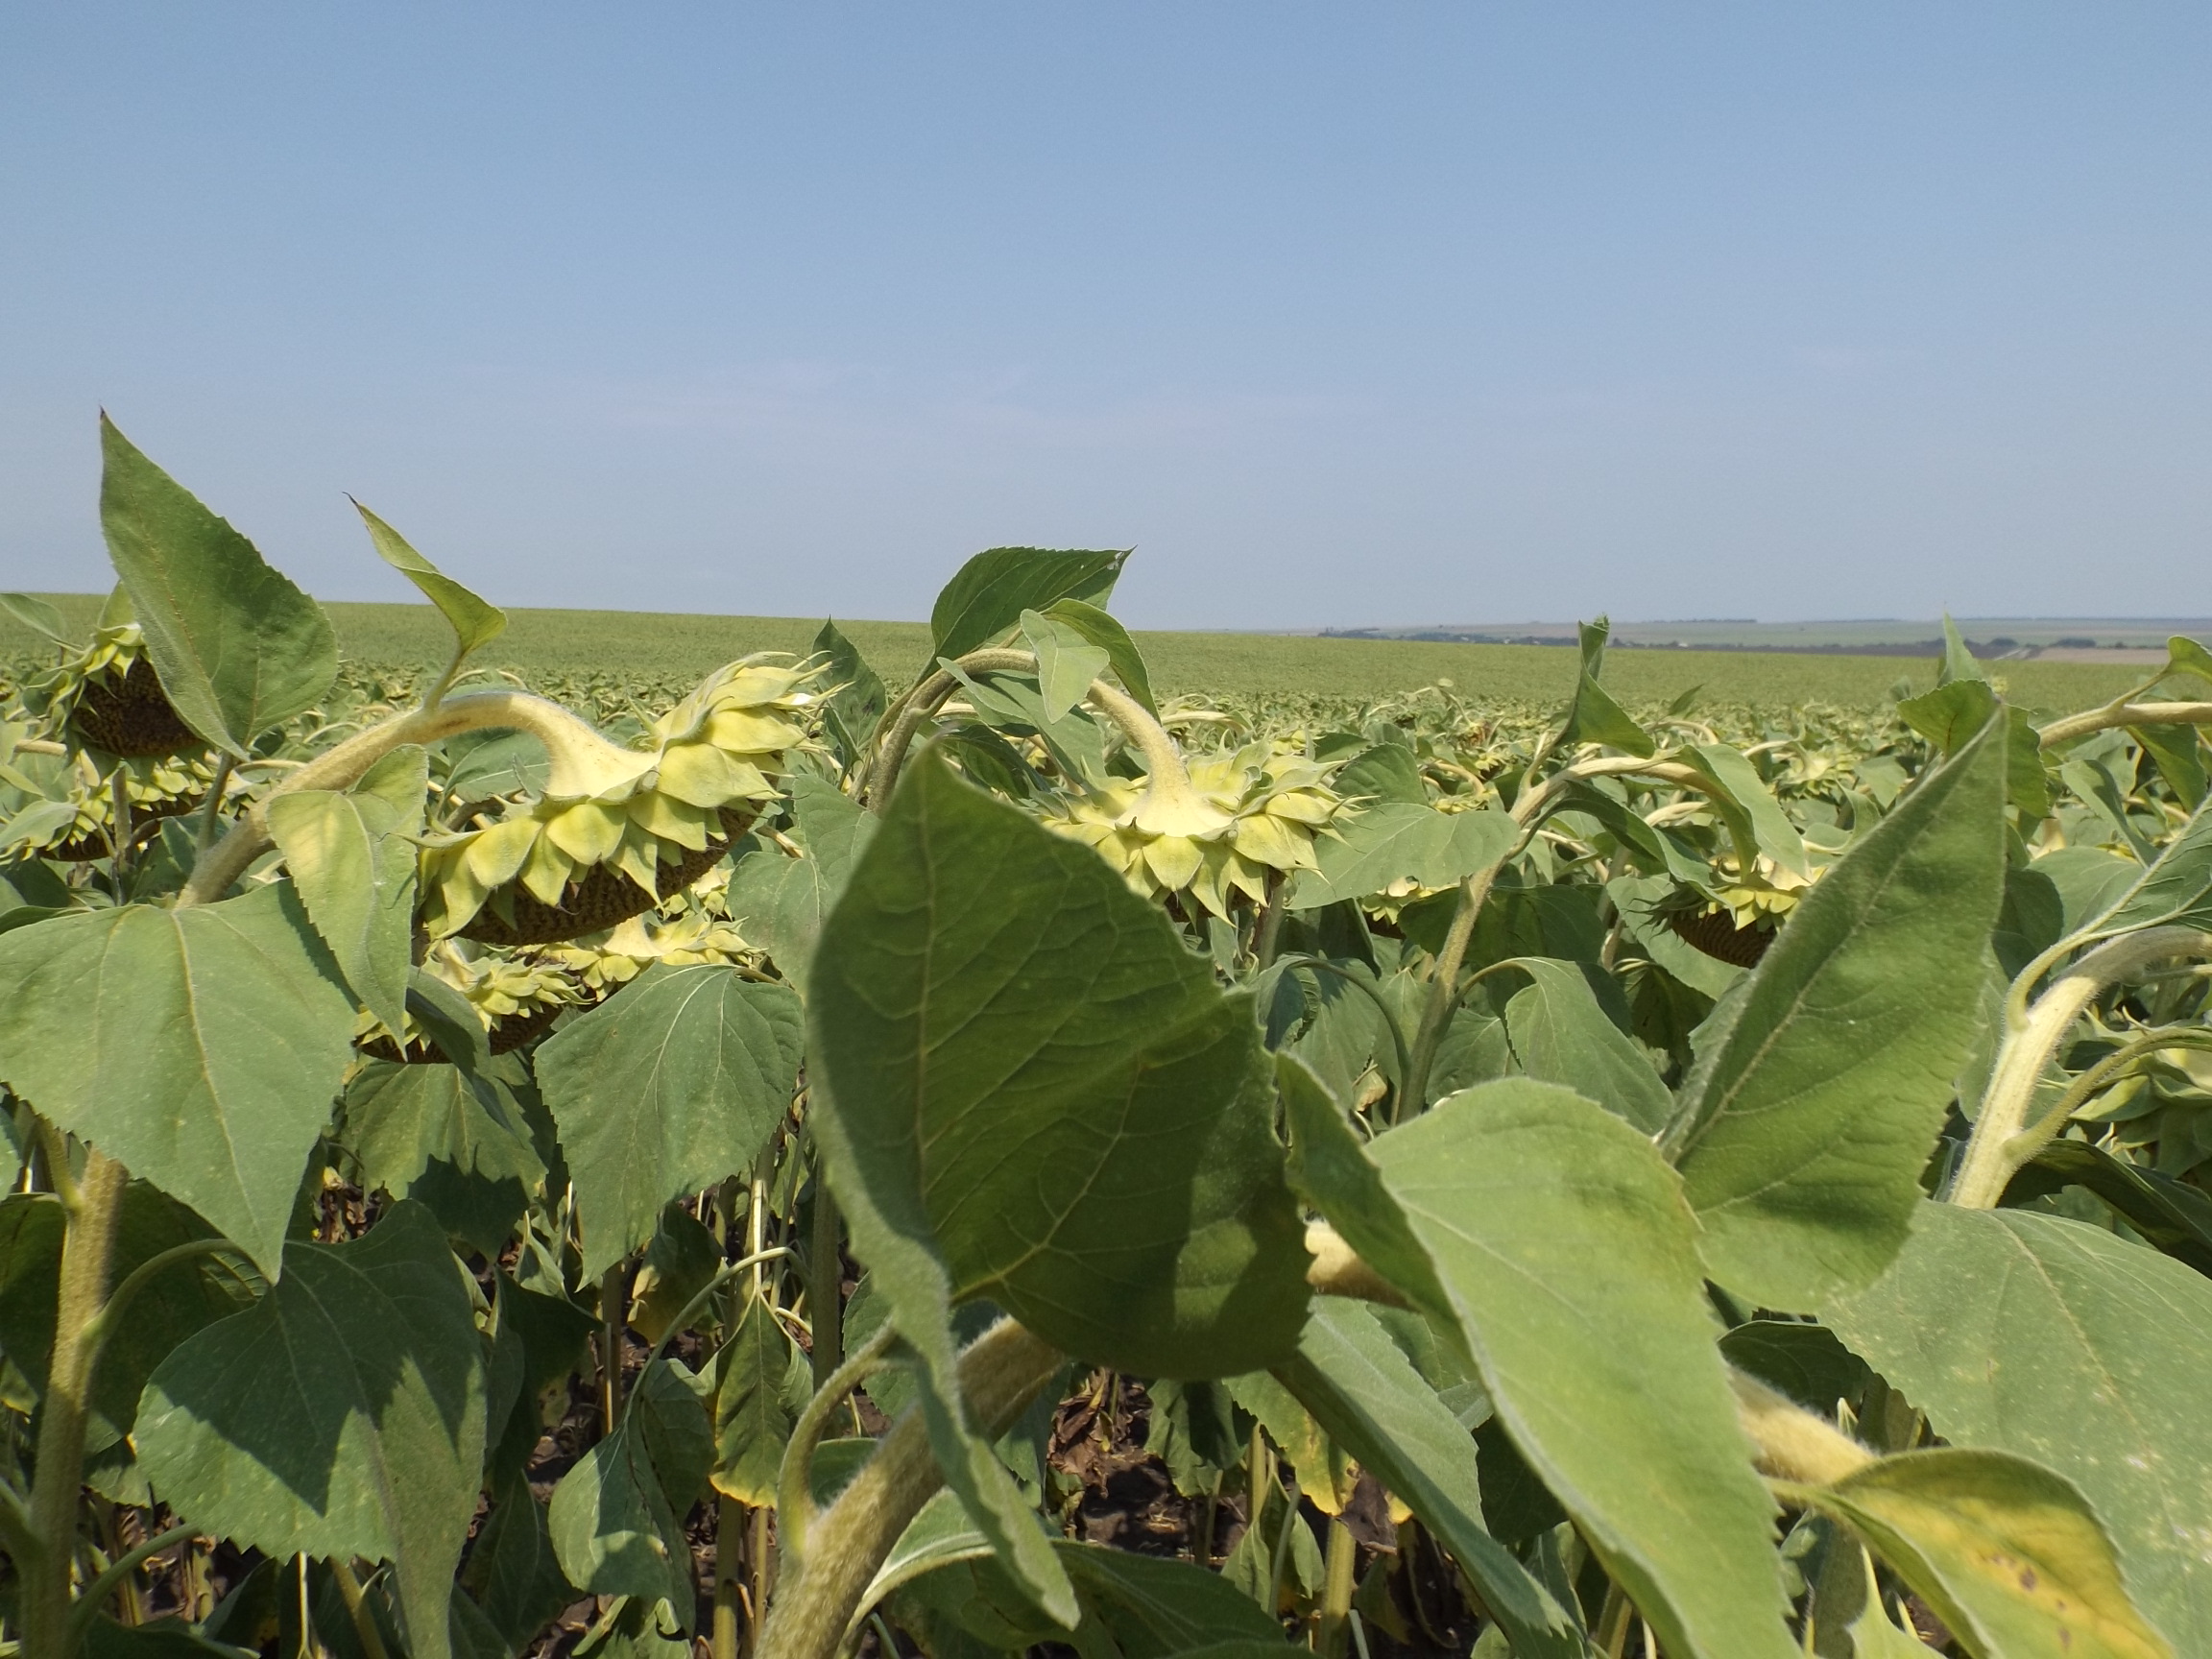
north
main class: Cropland
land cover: Sunflower
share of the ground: > 75 %
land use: Agriculture (excluding fallow land and kitchen gardens)
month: July
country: BG
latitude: 43.4623
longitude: 27.4705
